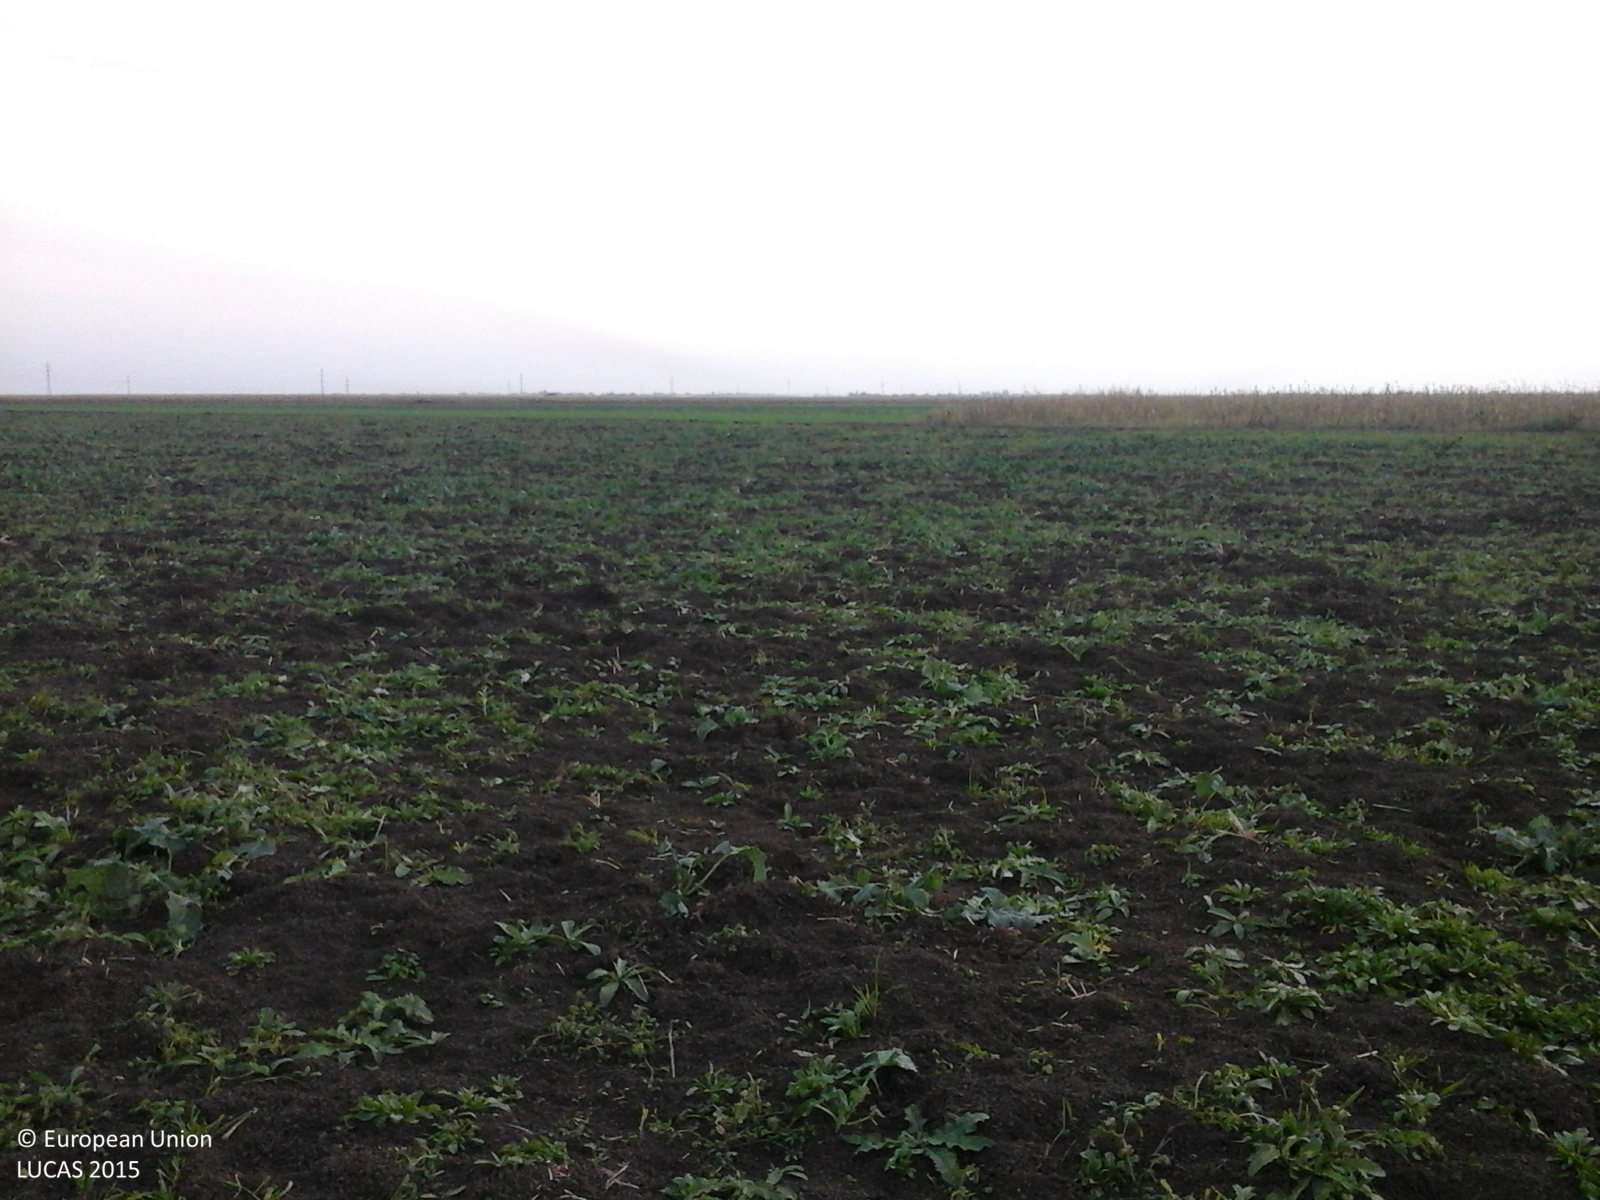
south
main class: Cropland
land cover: Rape and turnip rape
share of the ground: 50 - 75 %
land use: Agriculture (excluding fallow land and kitchen gardens)
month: October
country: RO
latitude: 45.1682
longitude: 26.7322
